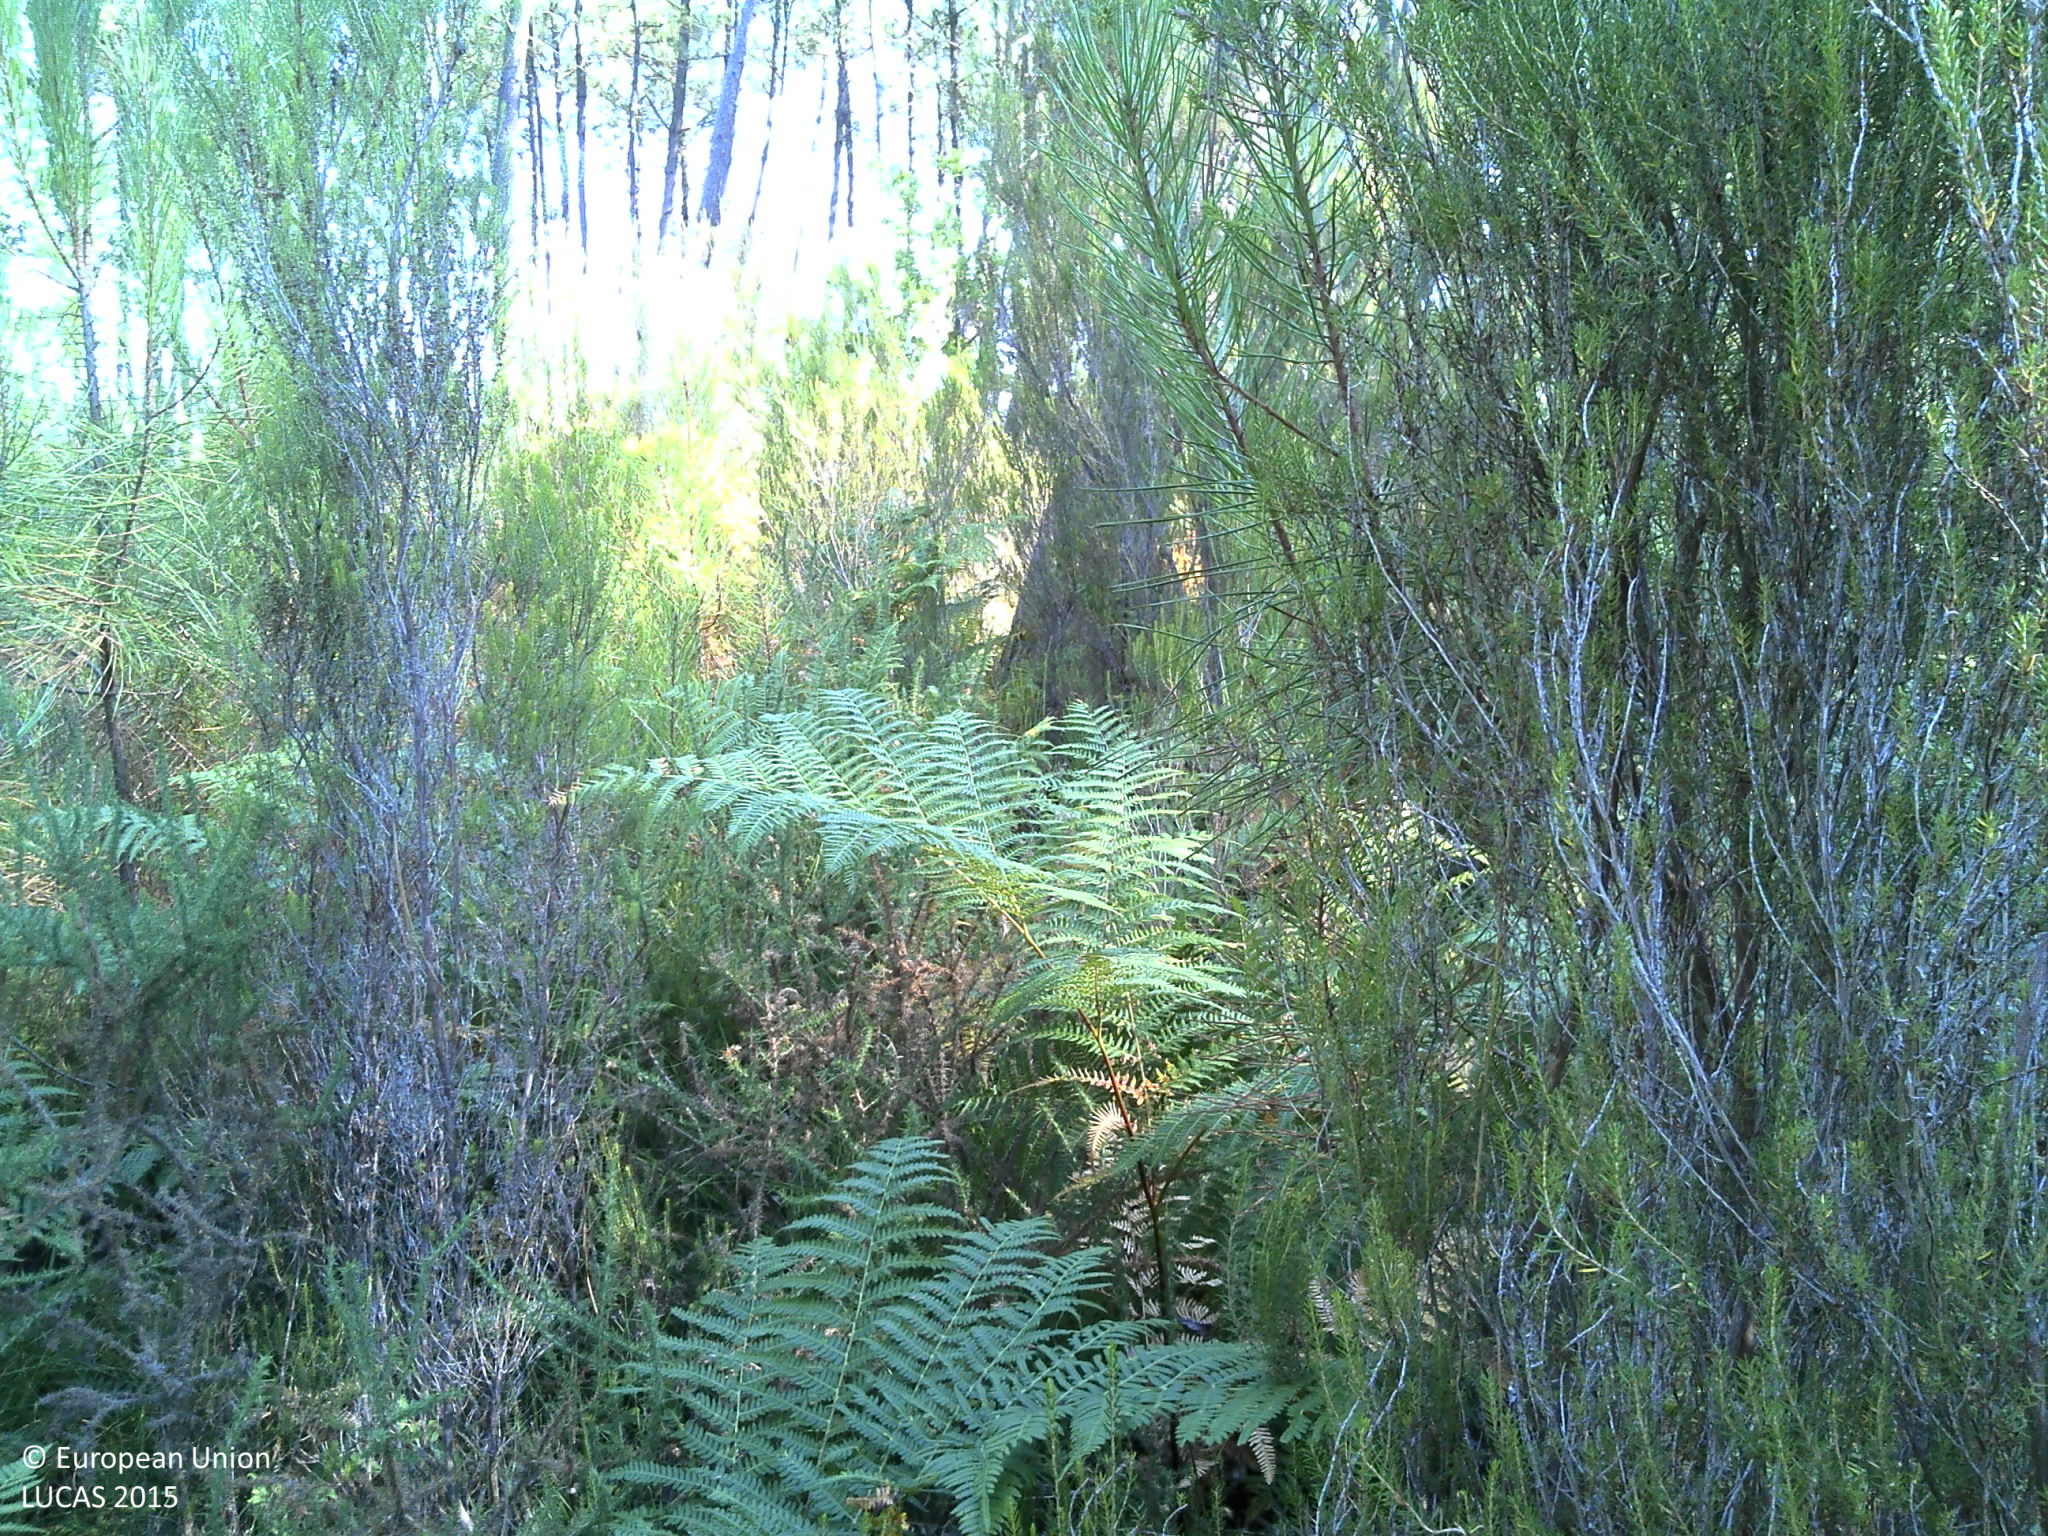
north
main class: Woodland
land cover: Pine dominated coniferous woodland
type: coniferous forest of the mediterranean region
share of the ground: > 75 %
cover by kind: coniferous forest trees 60 %, shrubs 30 %, herbaceous plants 5 %, lichens and mosses 5 %
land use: Forestry
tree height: > 5 m
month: August
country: FR
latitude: 45.0569
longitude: -0.9826
